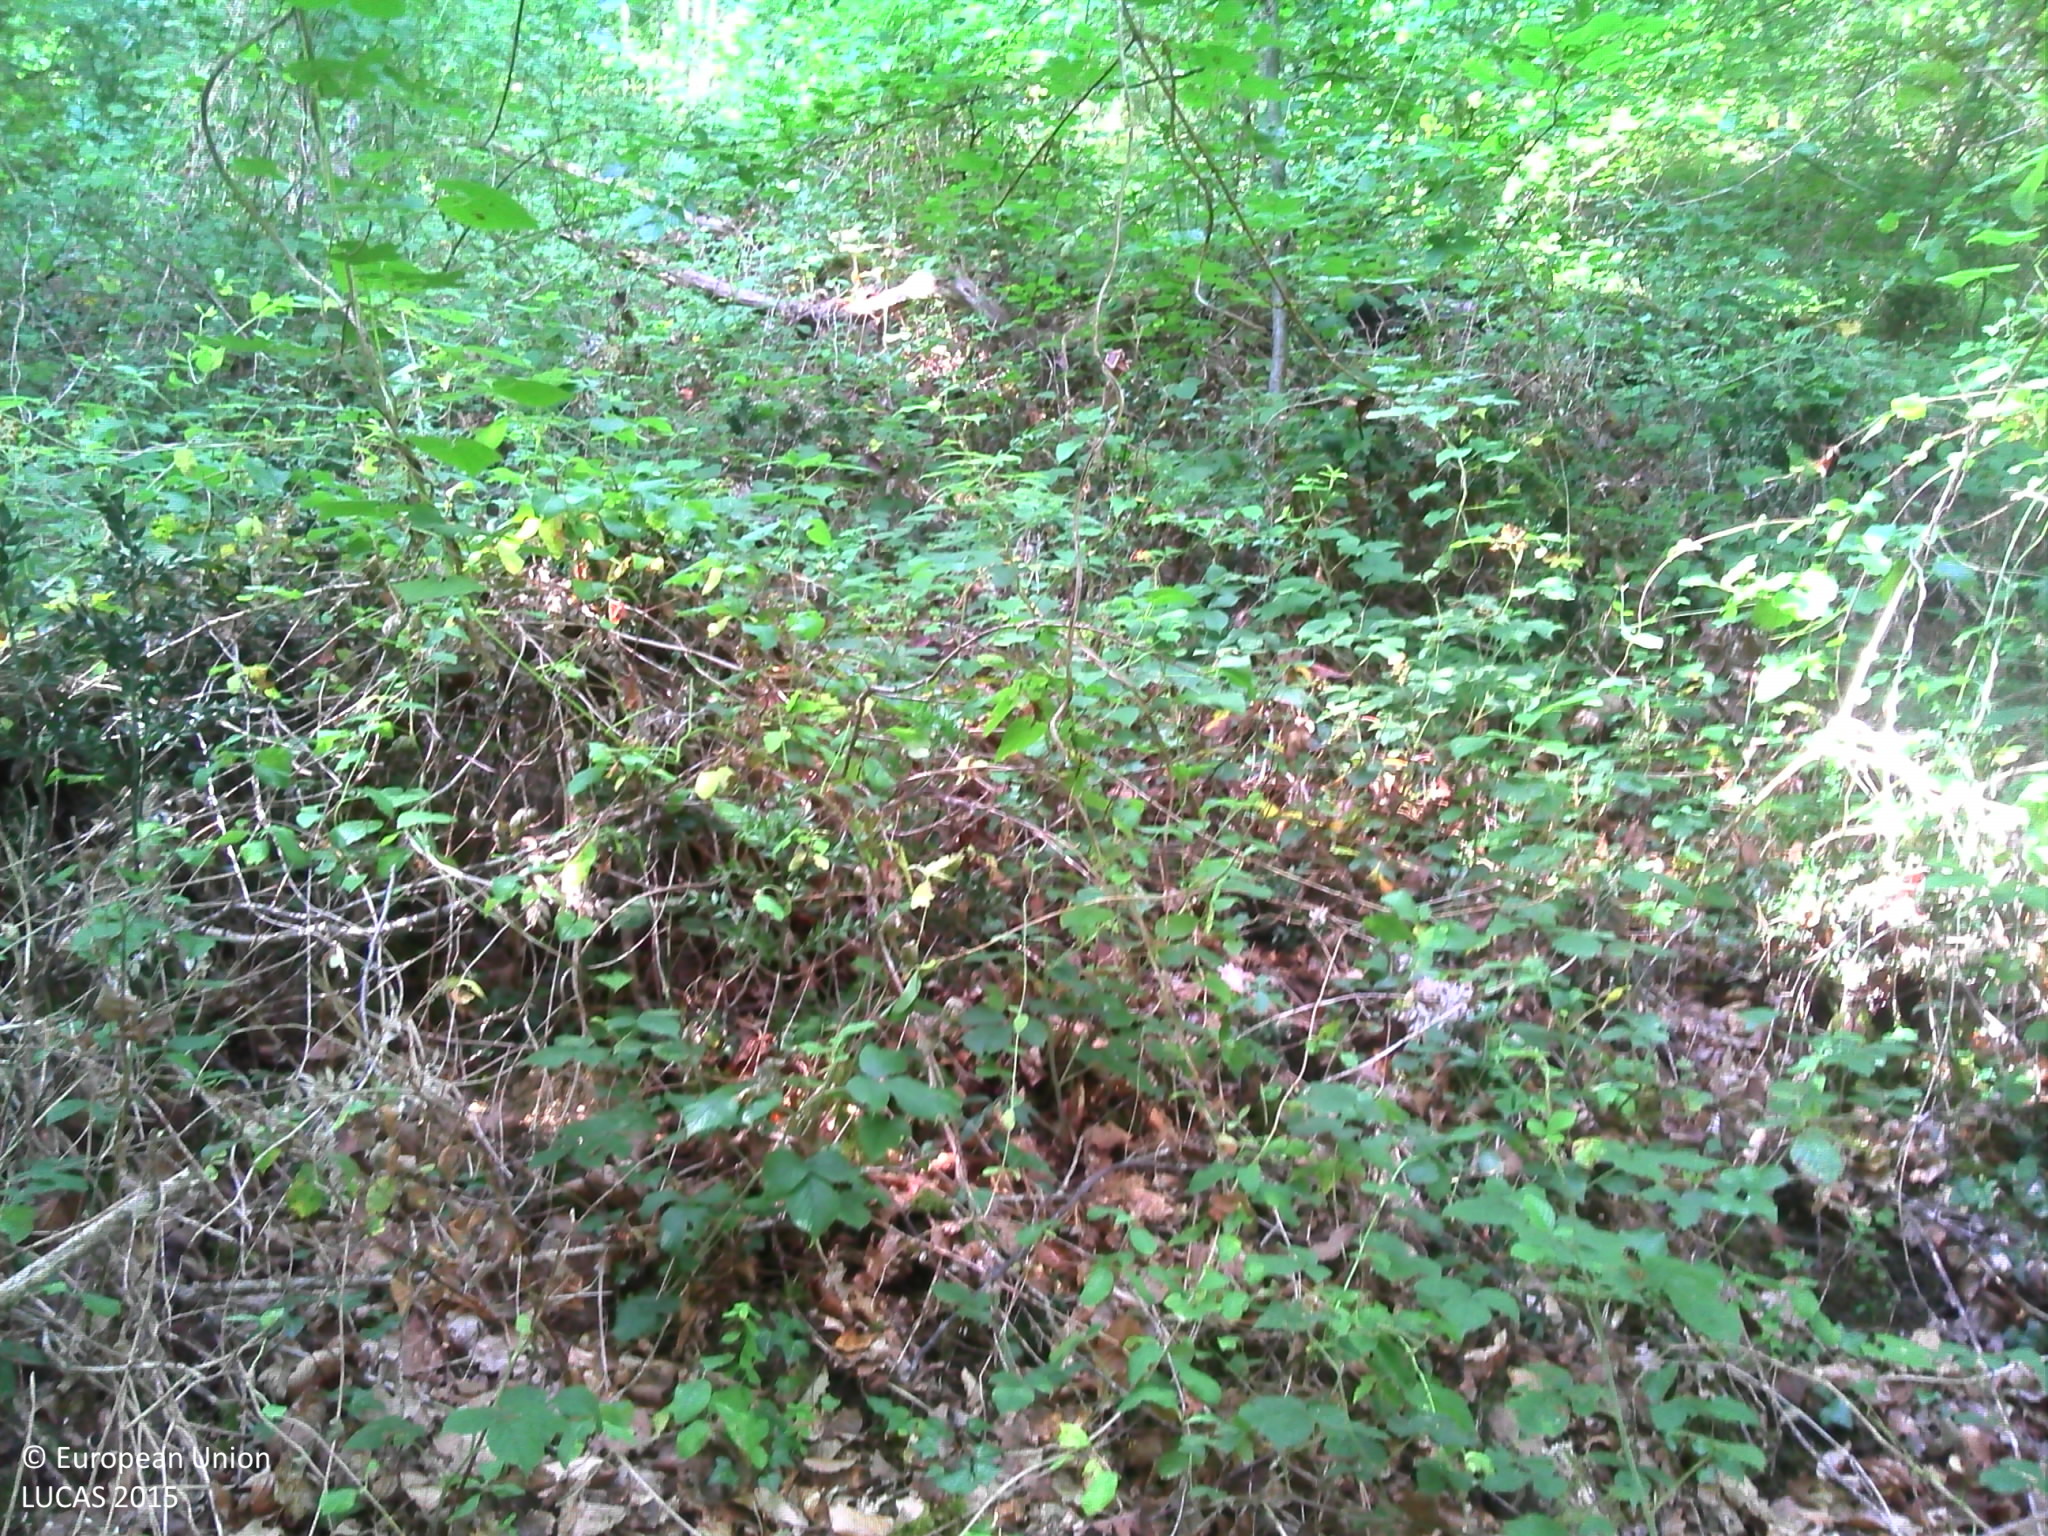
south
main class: Woodland
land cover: Broadleaved woodland
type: acidophilous oak and oak-birch forest
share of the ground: > 75 %
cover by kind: broadleaved forest trees 100 %
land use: Forestry
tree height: > 5 m
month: July
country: FR
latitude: 43.1615
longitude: 1.0125
